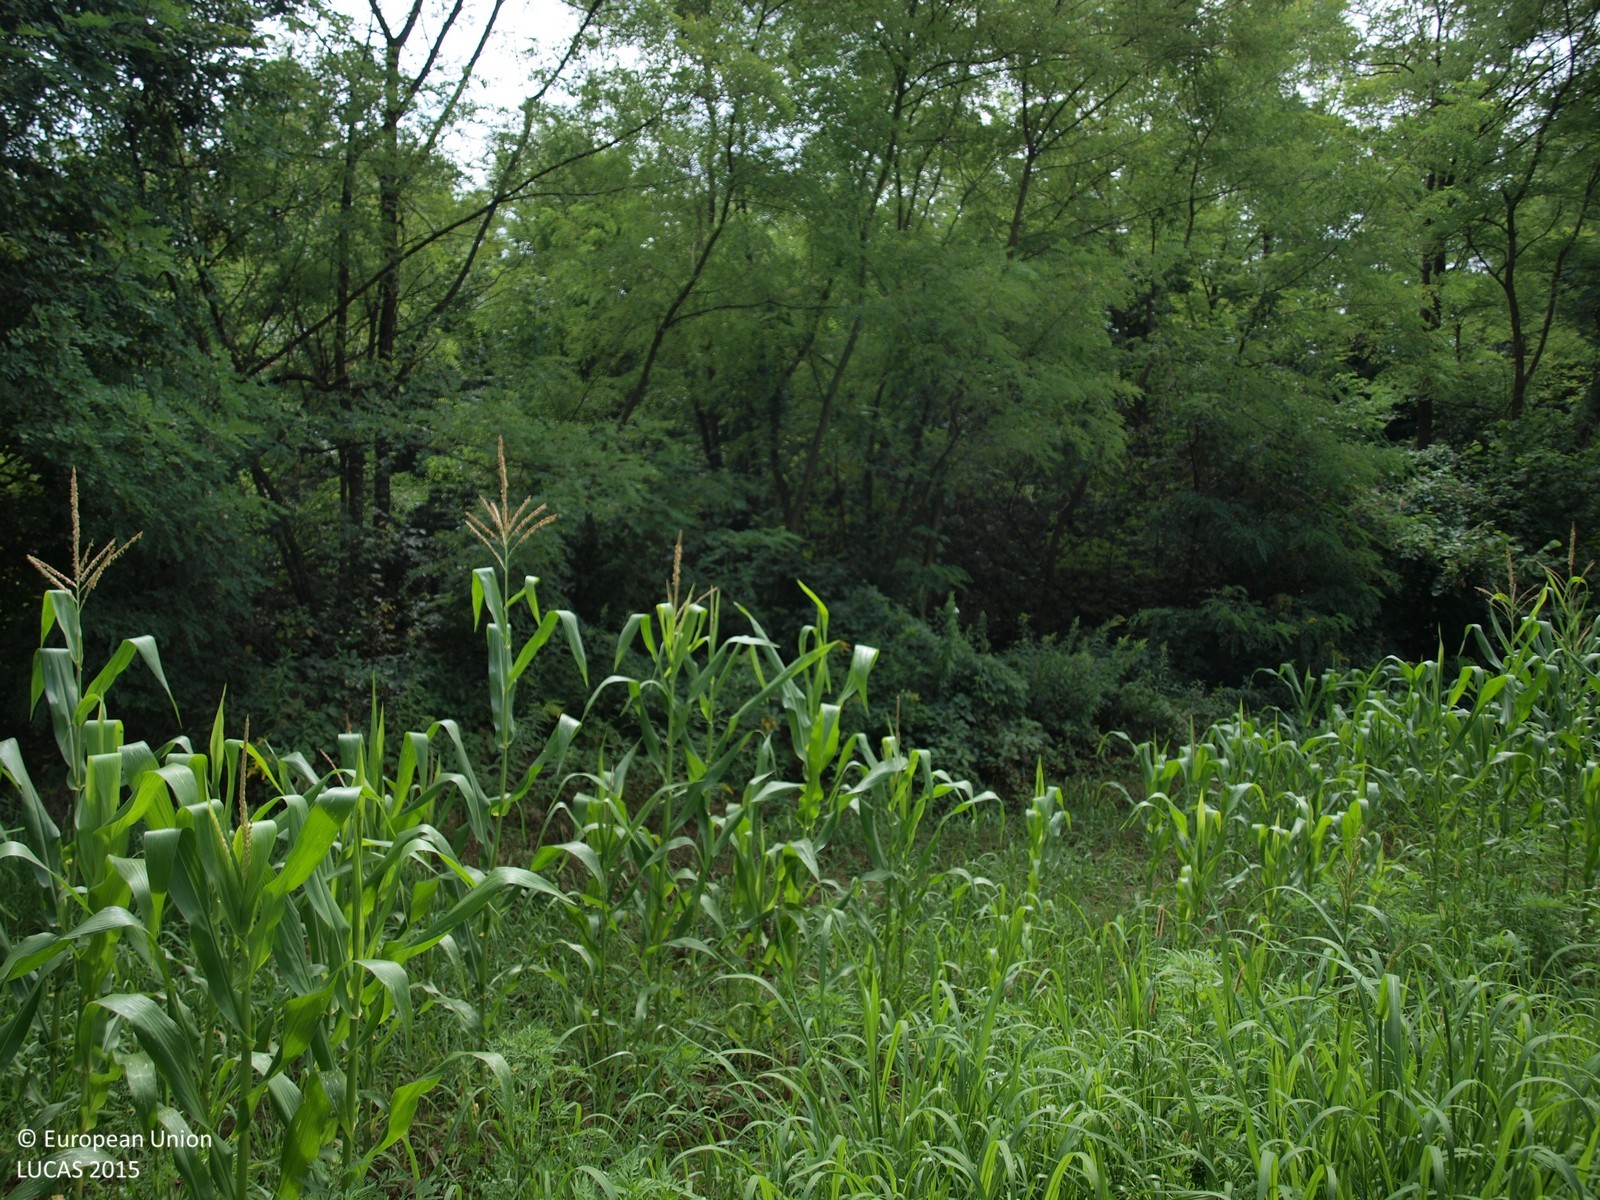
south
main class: Cropland
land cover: Maize
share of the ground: > 75 %
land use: Agriculture (excluding fallow land and kitchen gardens)
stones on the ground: < 10 %
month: August
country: HR
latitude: 45.9631
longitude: 16.3608
